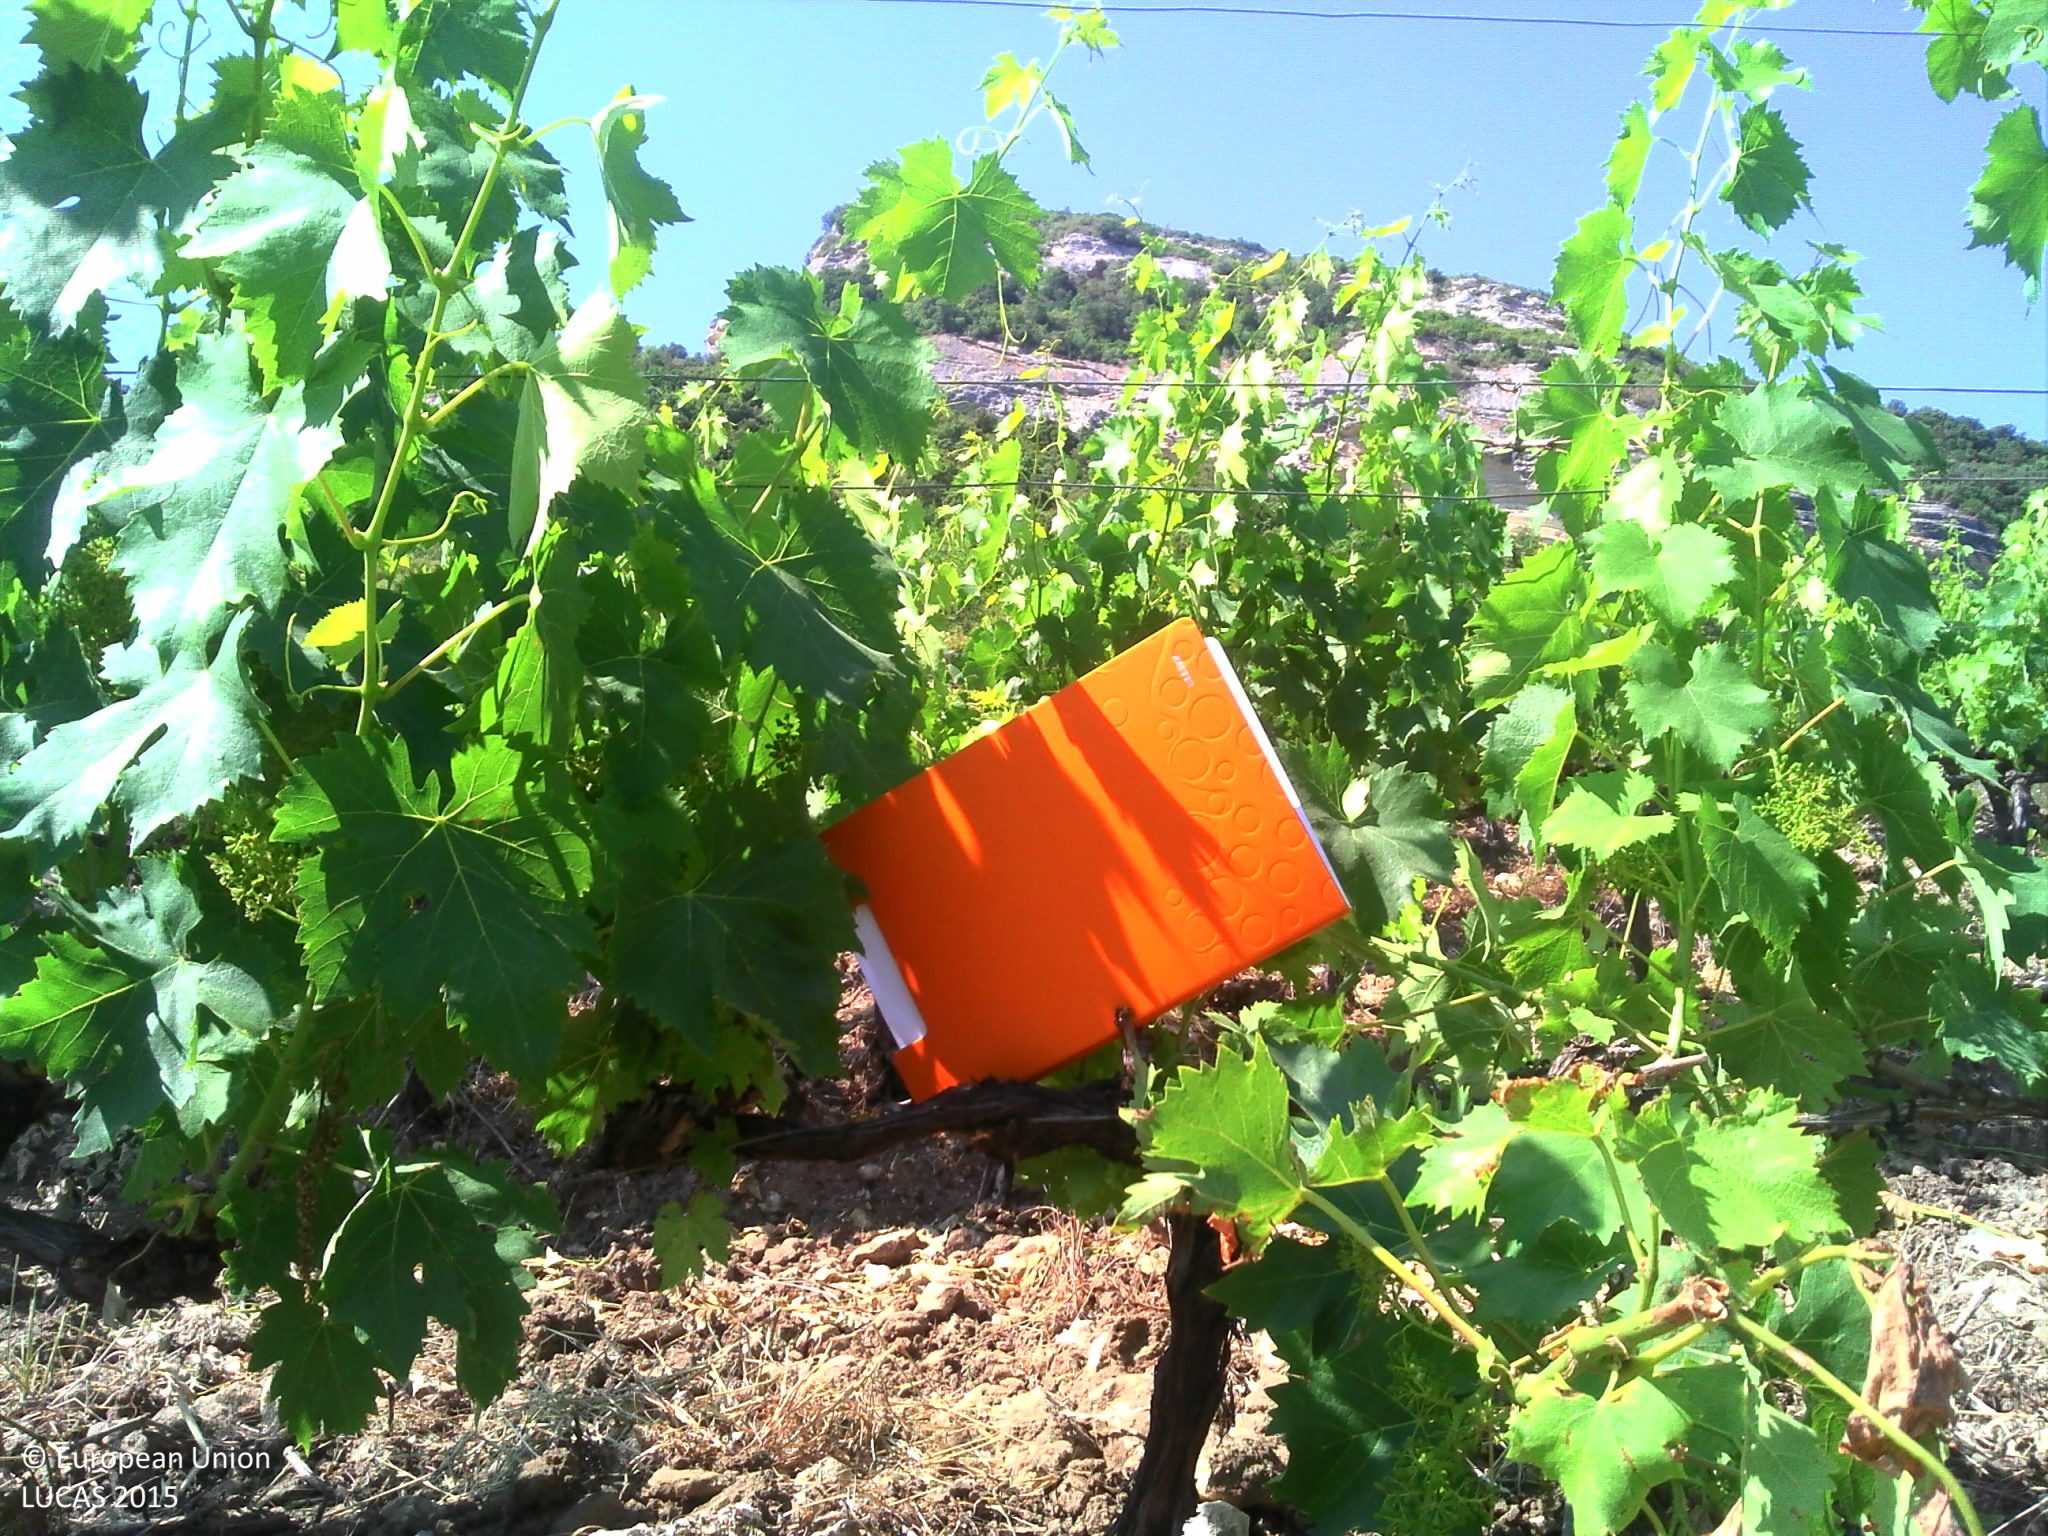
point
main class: Cropland
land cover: Vineyards
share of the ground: 50 - 75 %
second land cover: Other bare soil
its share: > 75 %
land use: Agriculture (excluding fallow land and kitchen gardens)
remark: Tilled/Sowed
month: June
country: FR
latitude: 42.6699
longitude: 9.3312
